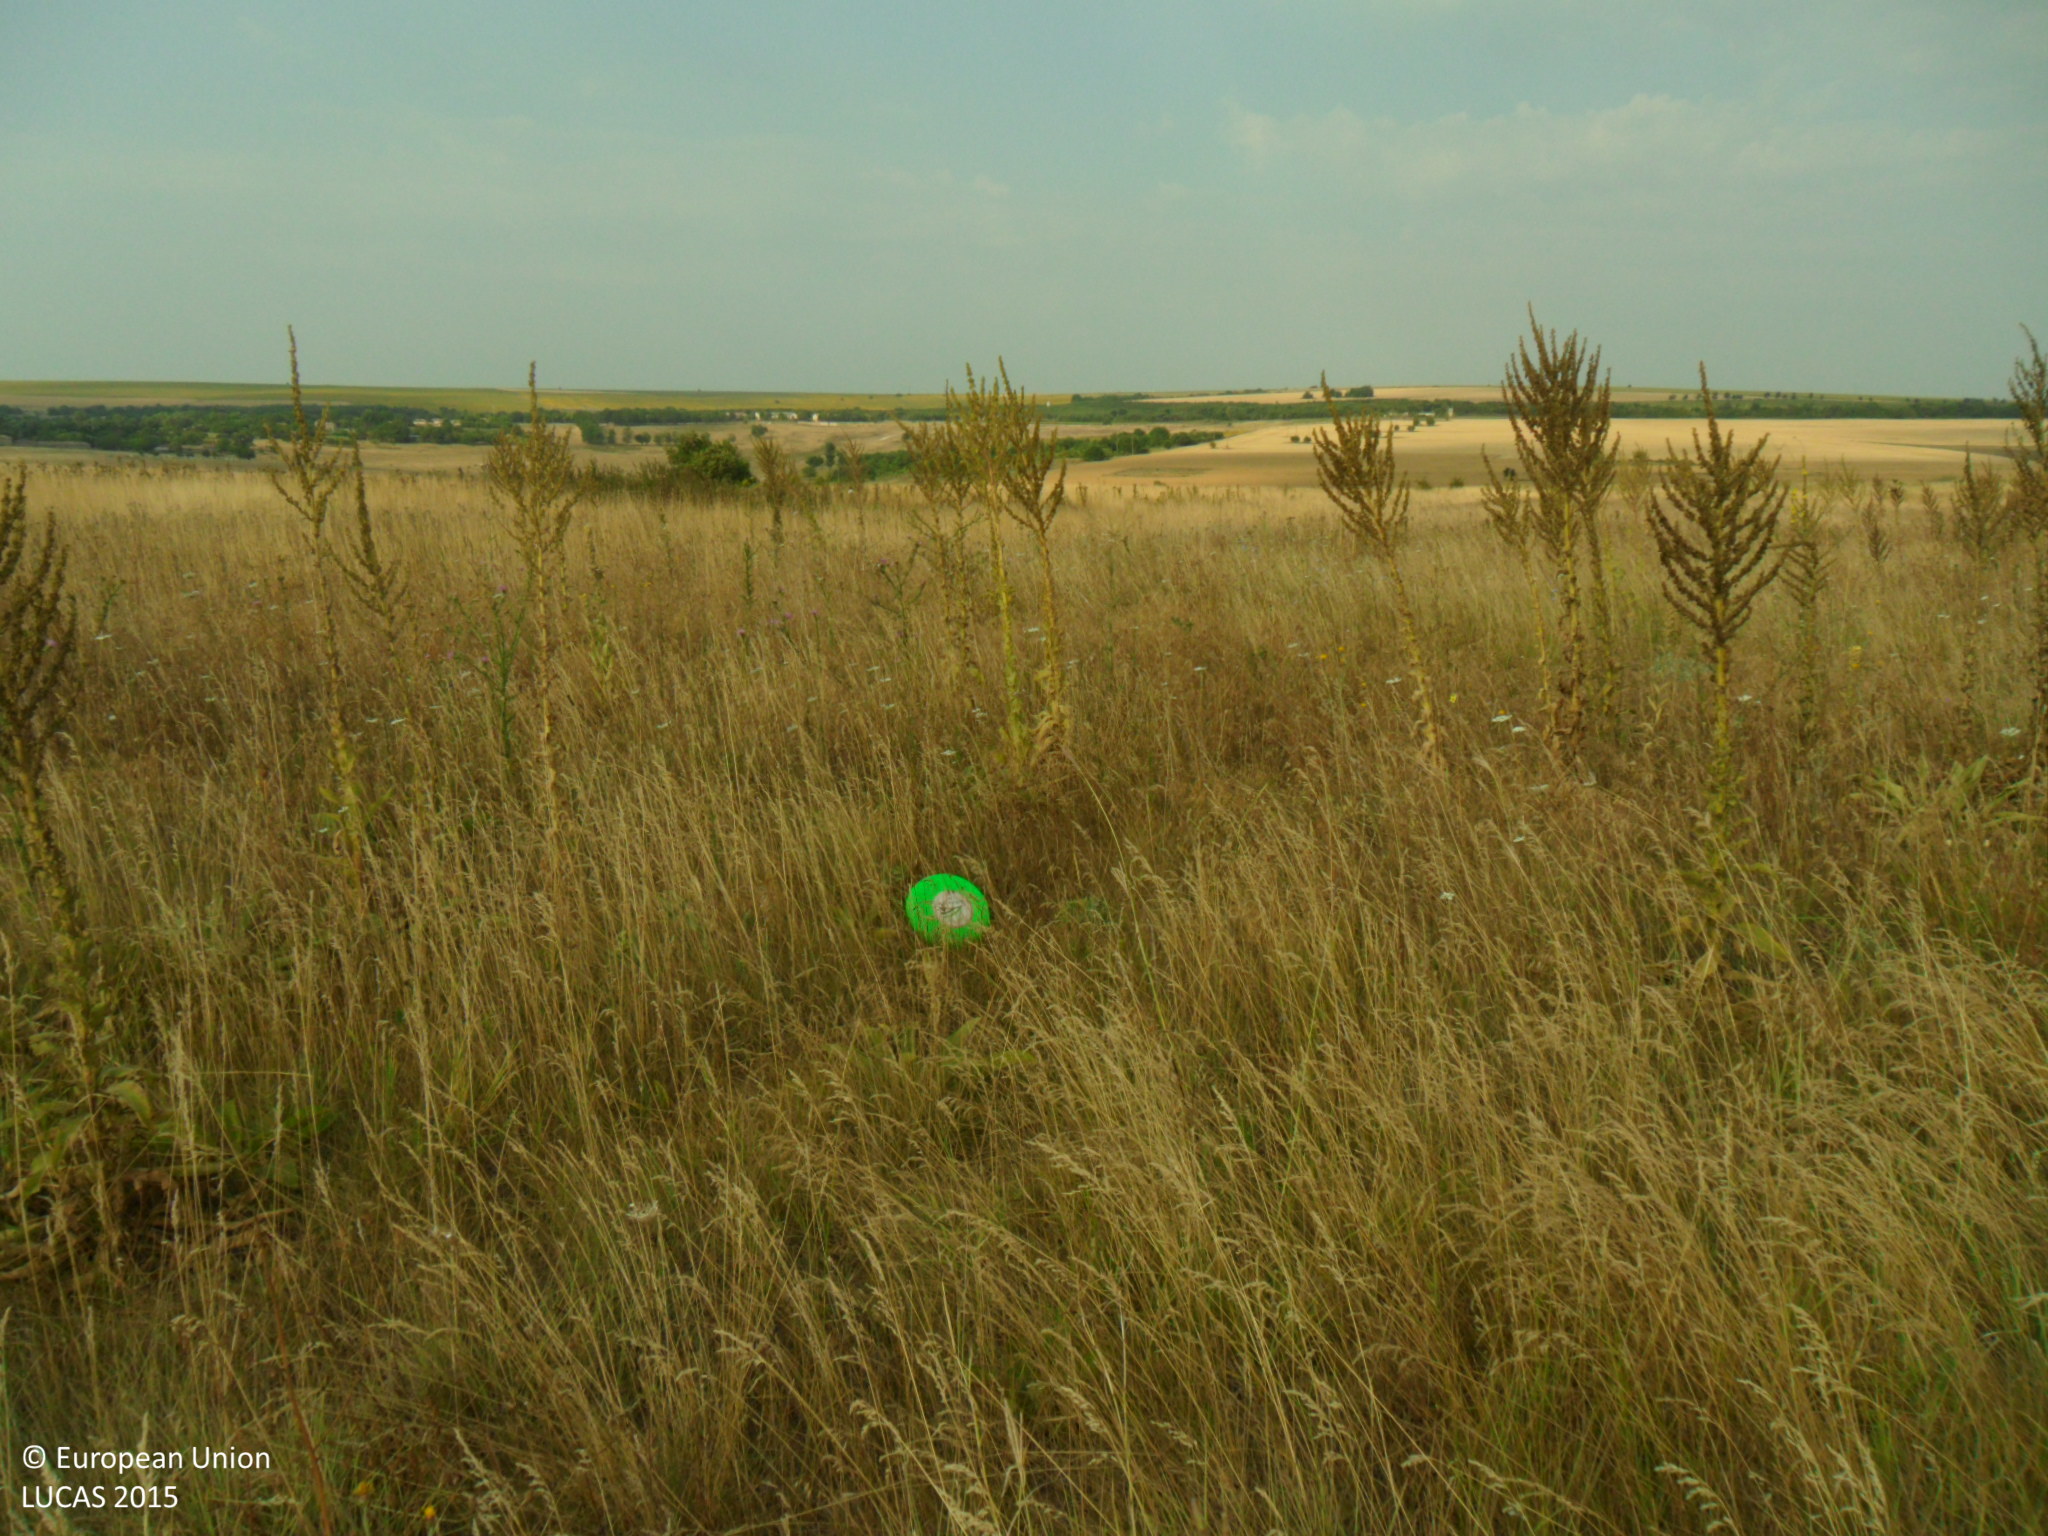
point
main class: Grassland
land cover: Spontaneously vegetated surfaces
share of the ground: > 75 %
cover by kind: herbaceous plants 100 %
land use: Fallow land
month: July
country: BG
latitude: 43.4180
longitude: 26.9745
